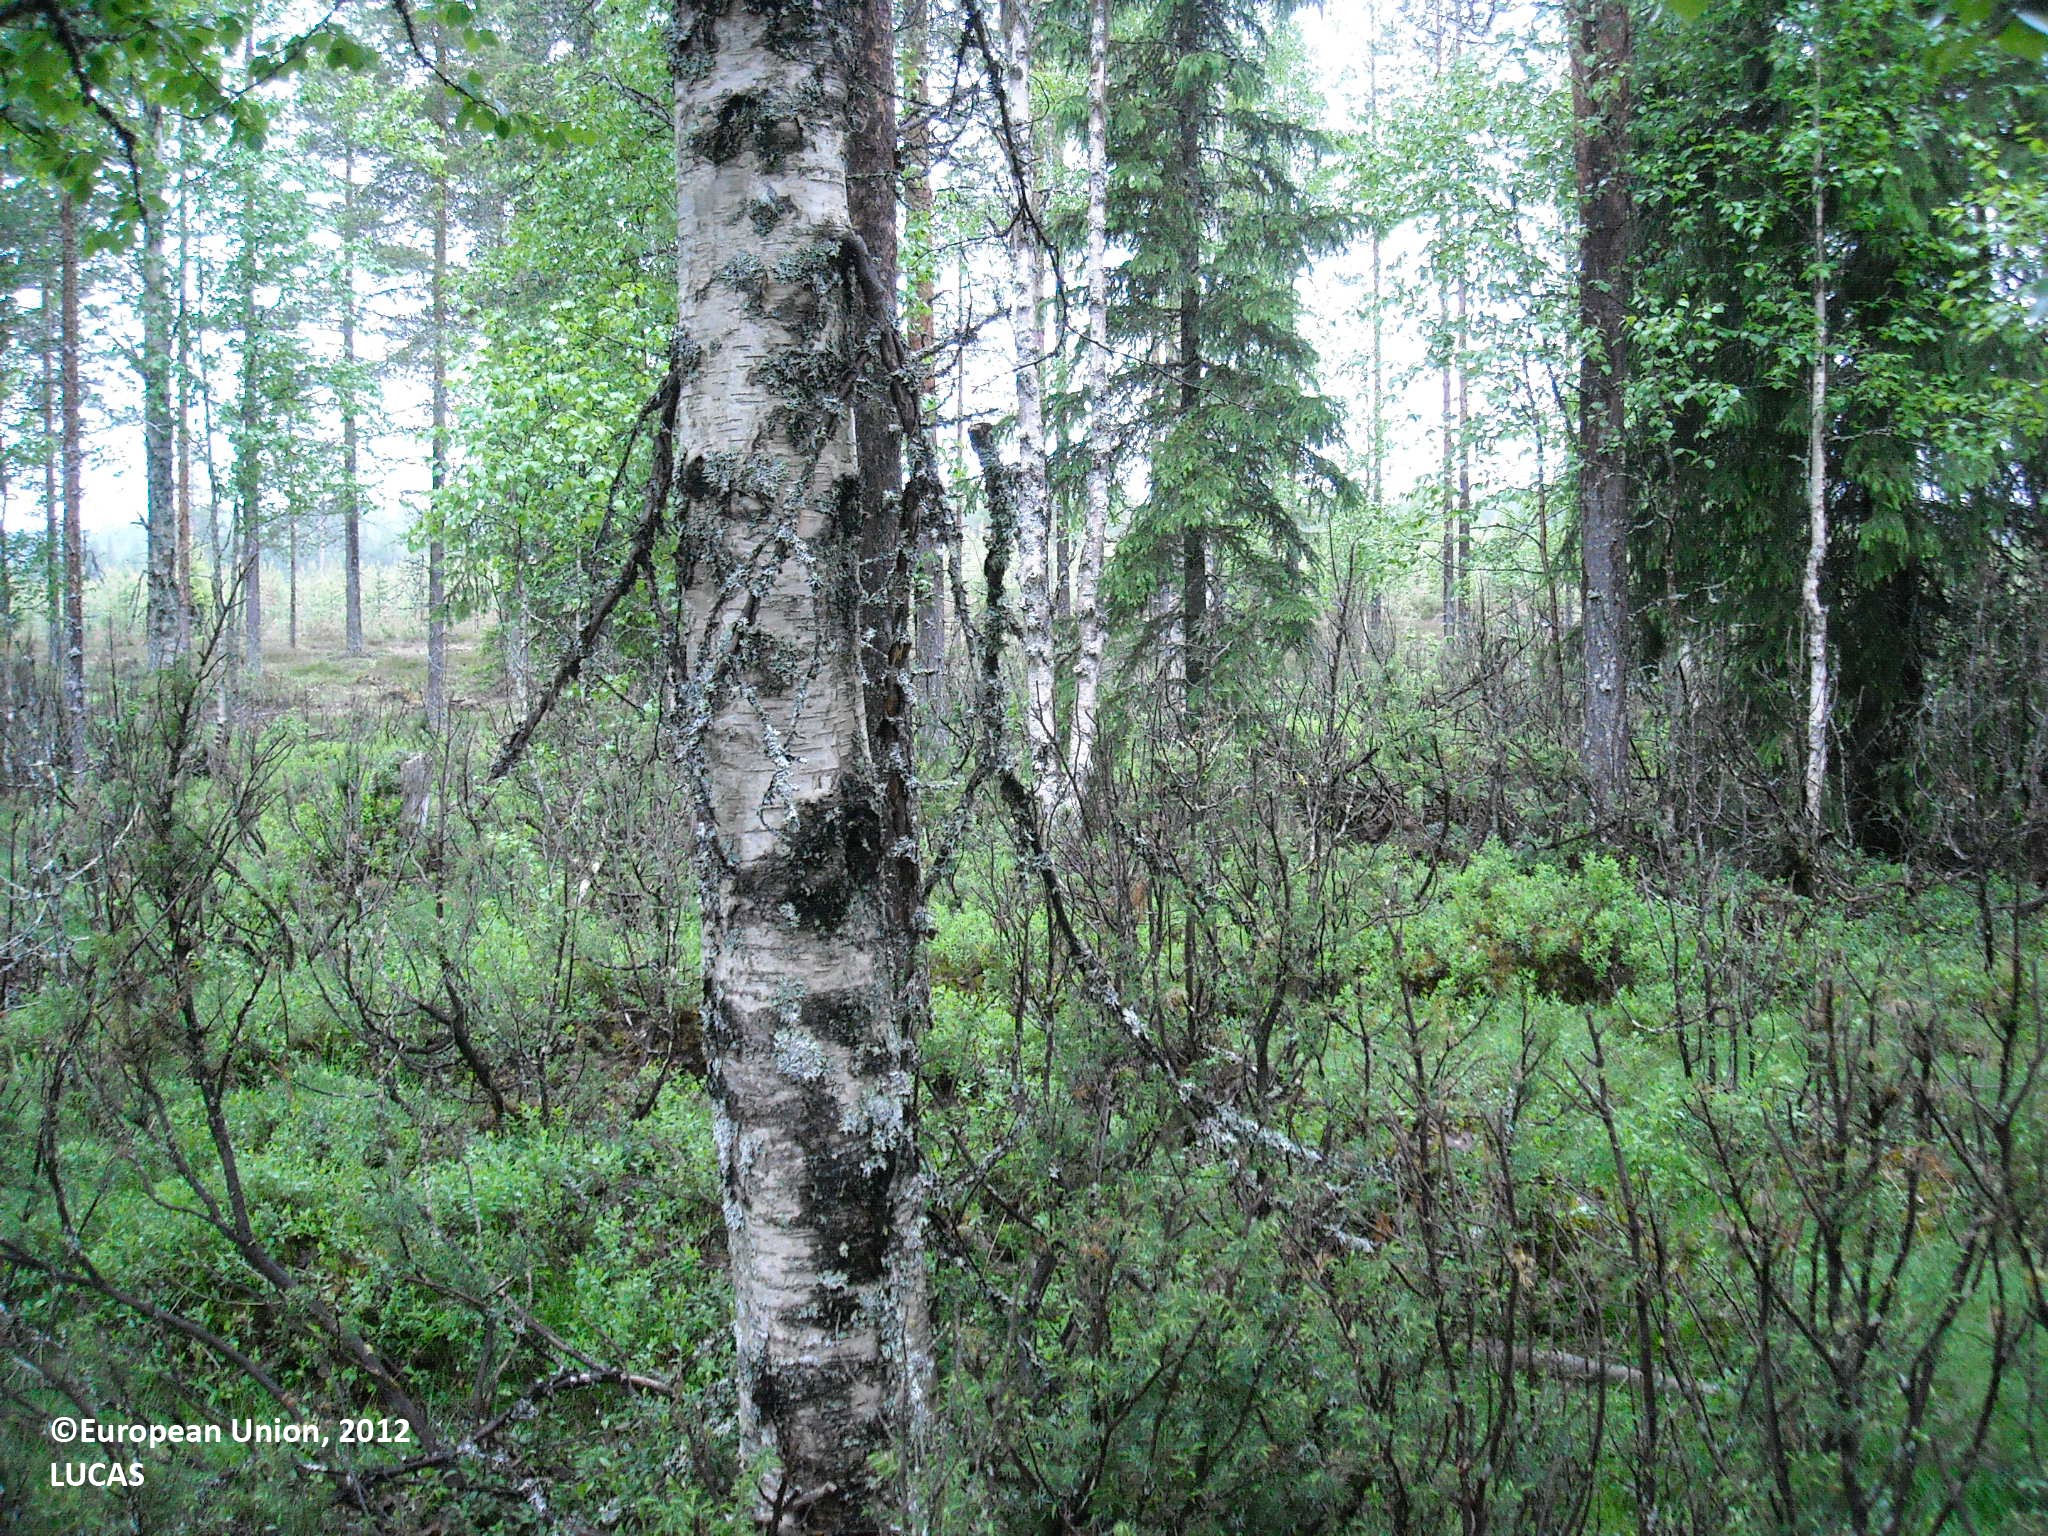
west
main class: Woodland
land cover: Other mixed woodland
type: boreal forest
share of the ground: > 75 %
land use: Forestry
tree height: > 5 m
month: June
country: FI
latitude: 65.4335
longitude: 27.9276
